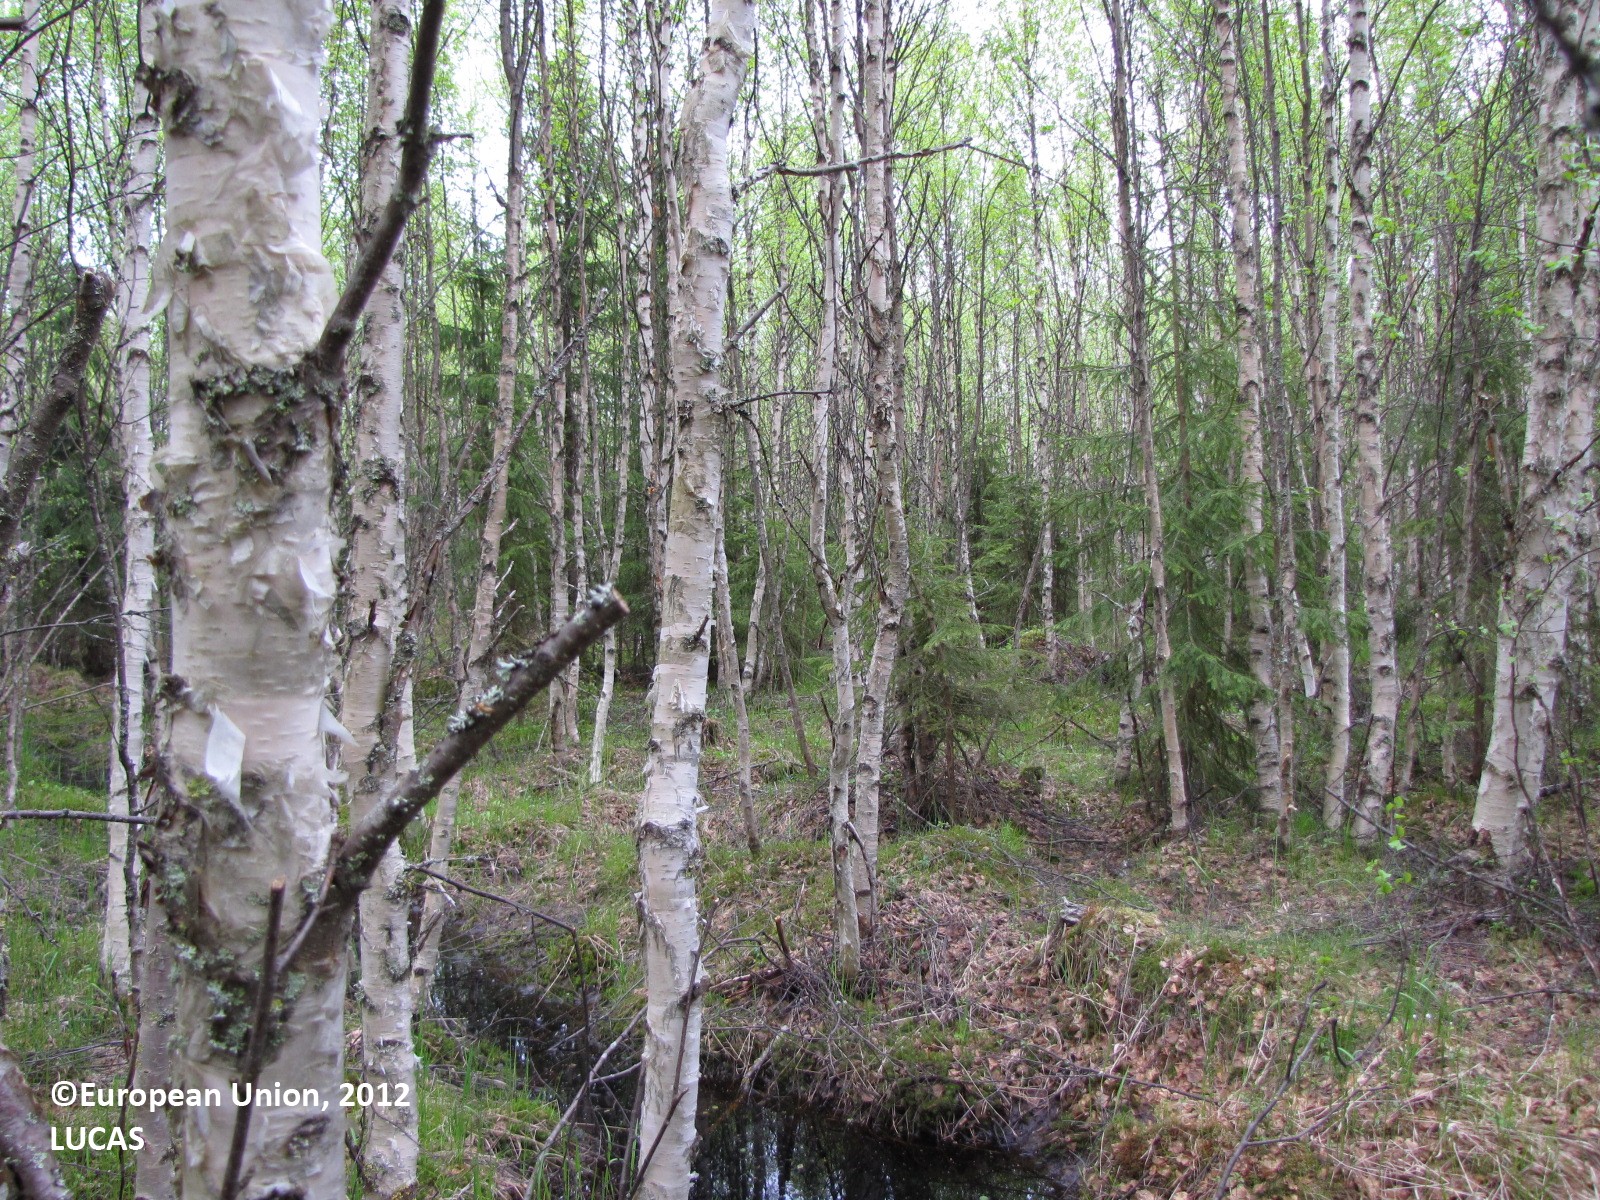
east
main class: Woodland
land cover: Spruce dominated mixed woodland
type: boreal forest
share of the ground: 50 - 75 %
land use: Forestry
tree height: > 5 m
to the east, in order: Spruce dominated mixed woodland; Ditches and canals; Spruce dominated mixed woodland; Ditches and canals; Spruce dominated mixed woodland; Ditches and canals; Spruce dominated mixed woodland; Ditches and canals; Spruce dominated mixed woodland; Ditches and canals; Spruce dominated mixed woodland; Ditches and canals; Spruce dominated mixed woodland; Ditches and canals; Spruce dominated mixed woodland; Ditches and canals; Spruce dominated mixed woodland; Ditches and canals; Spruce dominated mixed woodland; Ditches and canals; Spruce dominated mixed woodland; Ditches and canals; Spruce dominated mixed woodland; Ditches and canals; Spruce dominated mixed woodland; Ditches and canals; Spruce dominated mixed woodland
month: June
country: FI
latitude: 65.8462
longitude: 24.5305
